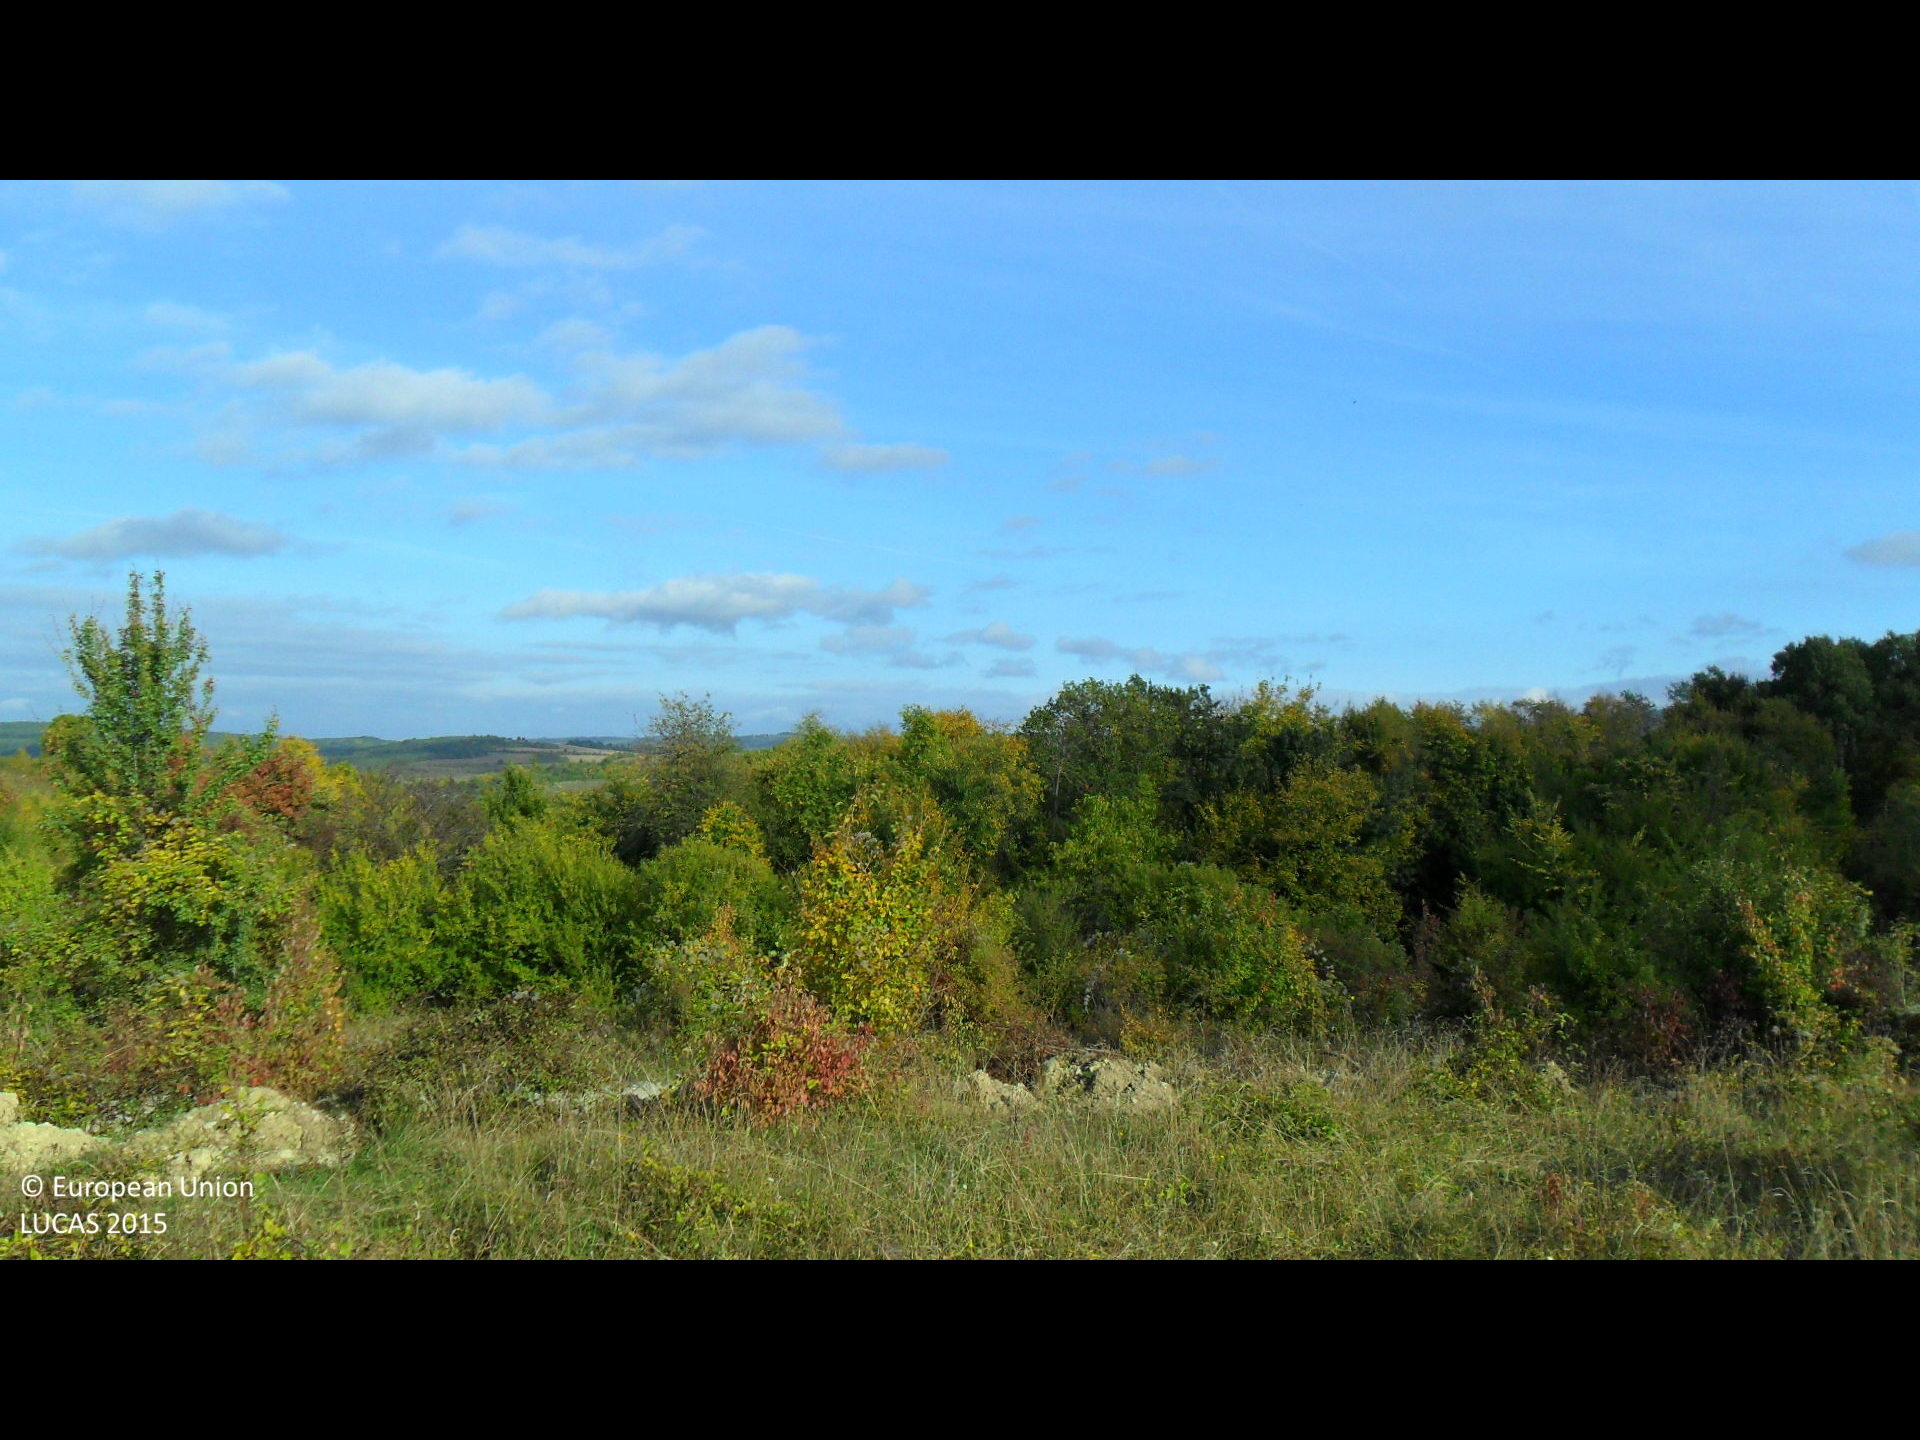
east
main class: Grassland
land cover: Grassland with sparse tree/shrub cover
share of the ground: > 75 %
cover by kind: herbaceous plants 90 %, broadleaved forest trees 5 %, shrubs 5 %
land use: Agriculture (excluding fallow land and kitchen gardens)
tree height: < 5 m
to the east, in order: Grassland with sparse tree/shrub cover; Paved roads, cycling and walking lanes; Sunflower; Shrubland with sparse tree cover; Paved roads, cycling and walking lanes; Broadleaved woodland; Shrubland with sparse tree cover; Rivers and streams; Broadleaved woodland
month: October
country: BG
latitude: 43.0725
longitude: 26.1677
